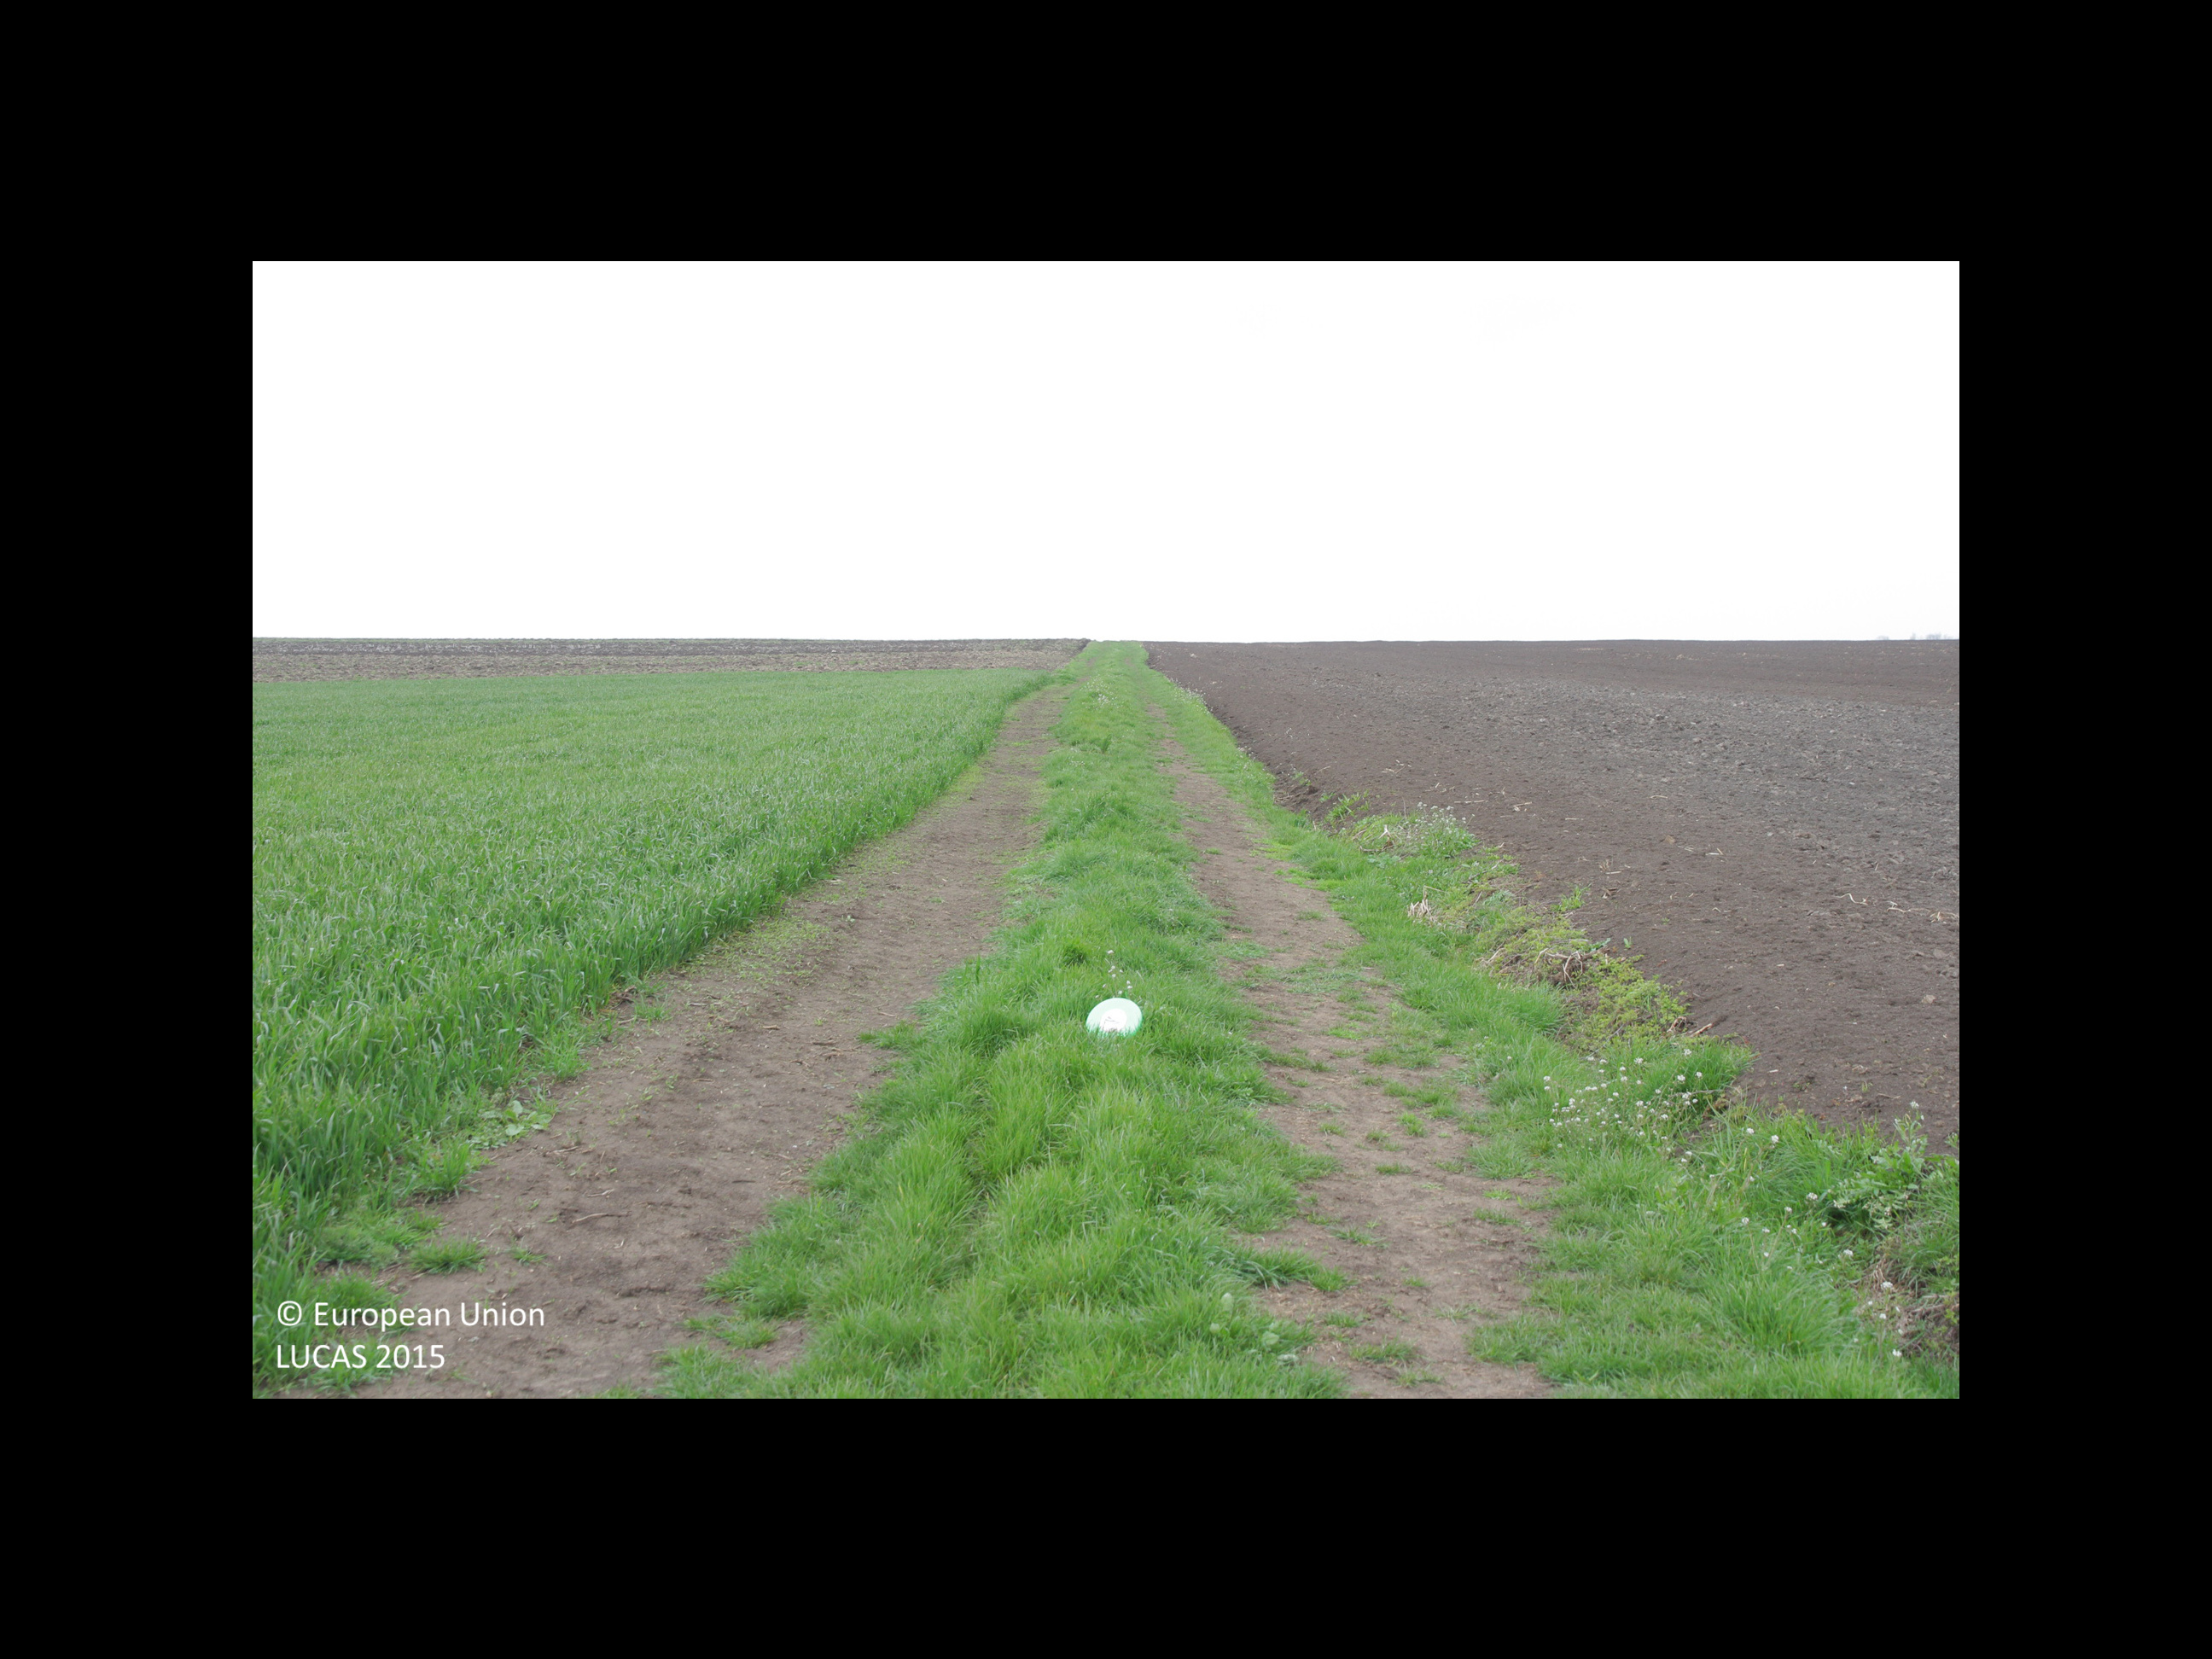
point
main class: Cropland
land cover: Common wheat
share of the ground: > 75 %
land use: Agriculture (excluding fallow land and kitchen gardens)
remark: Harvested field
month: July
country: BG
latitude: 43.7889
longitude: 26.3970
